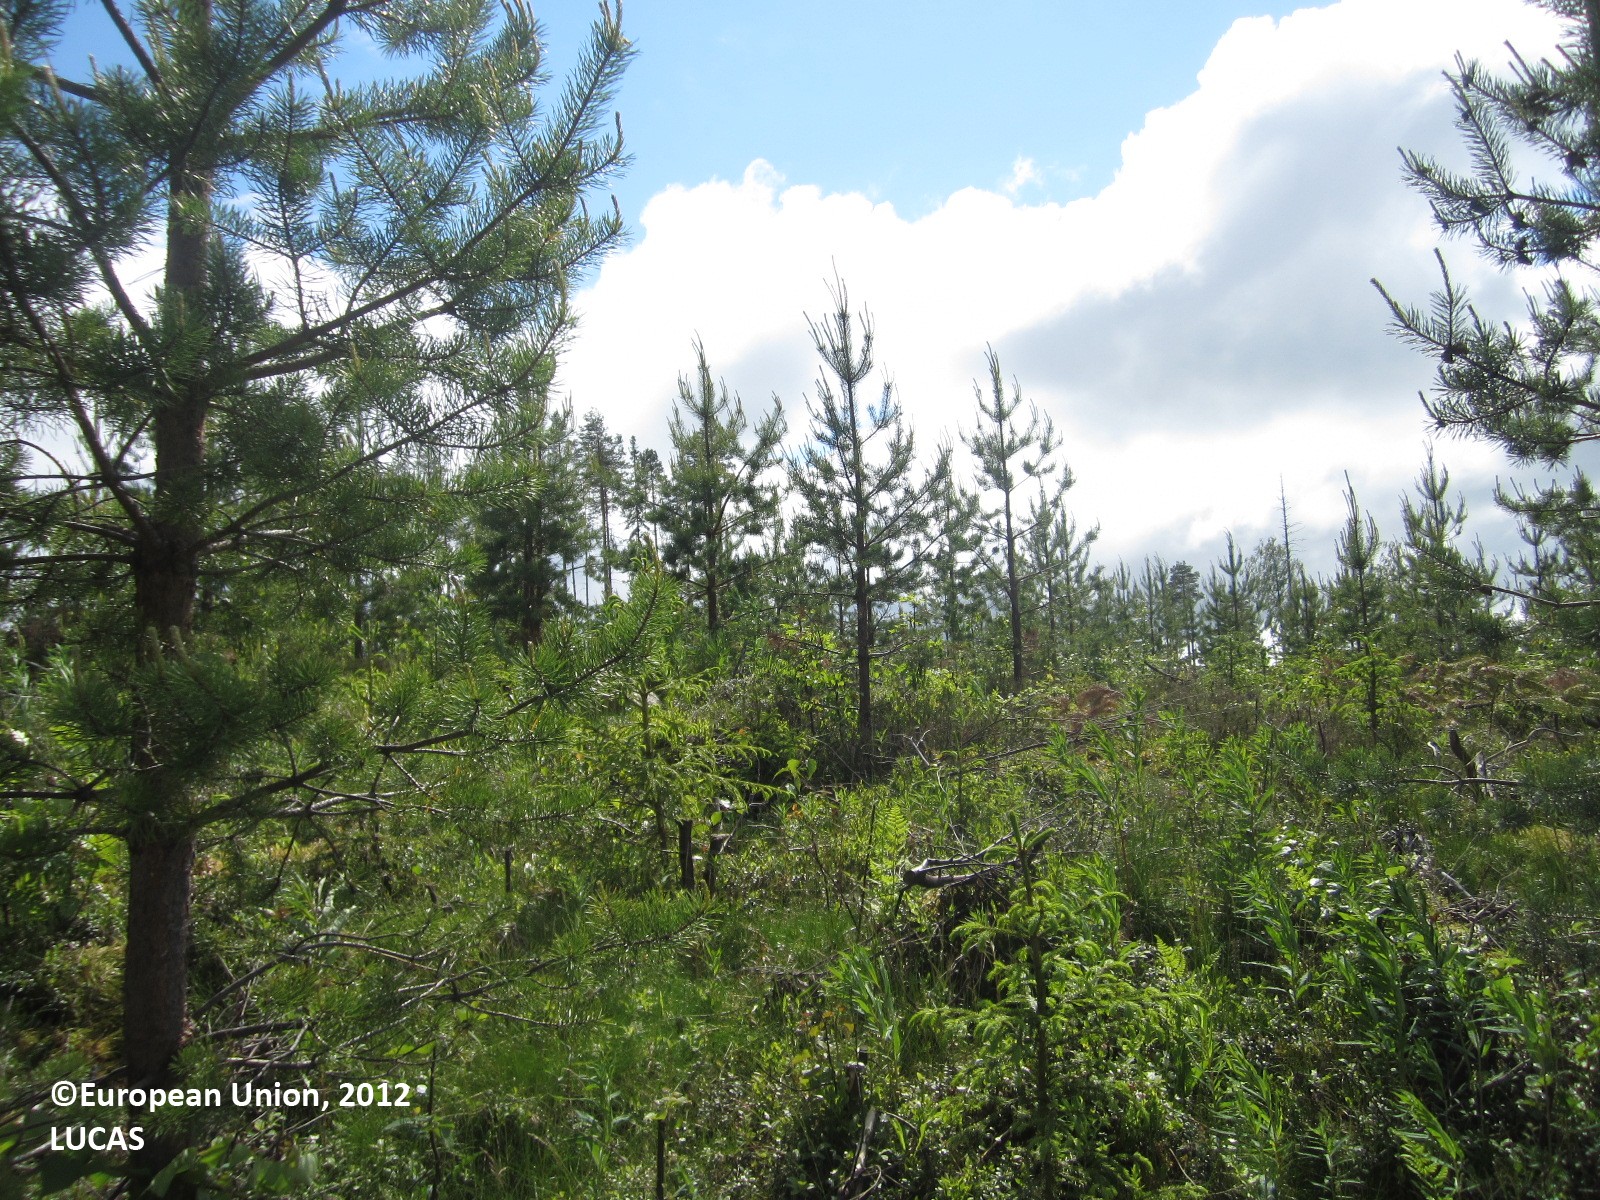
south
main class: Woodland
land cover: Spruce dominated coniferous woodland
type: boreal forest
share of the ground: 25 - 50 %
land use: Forestry
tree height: < 5 m
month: June
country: FI
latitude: 64.3541
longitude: 29.7536
